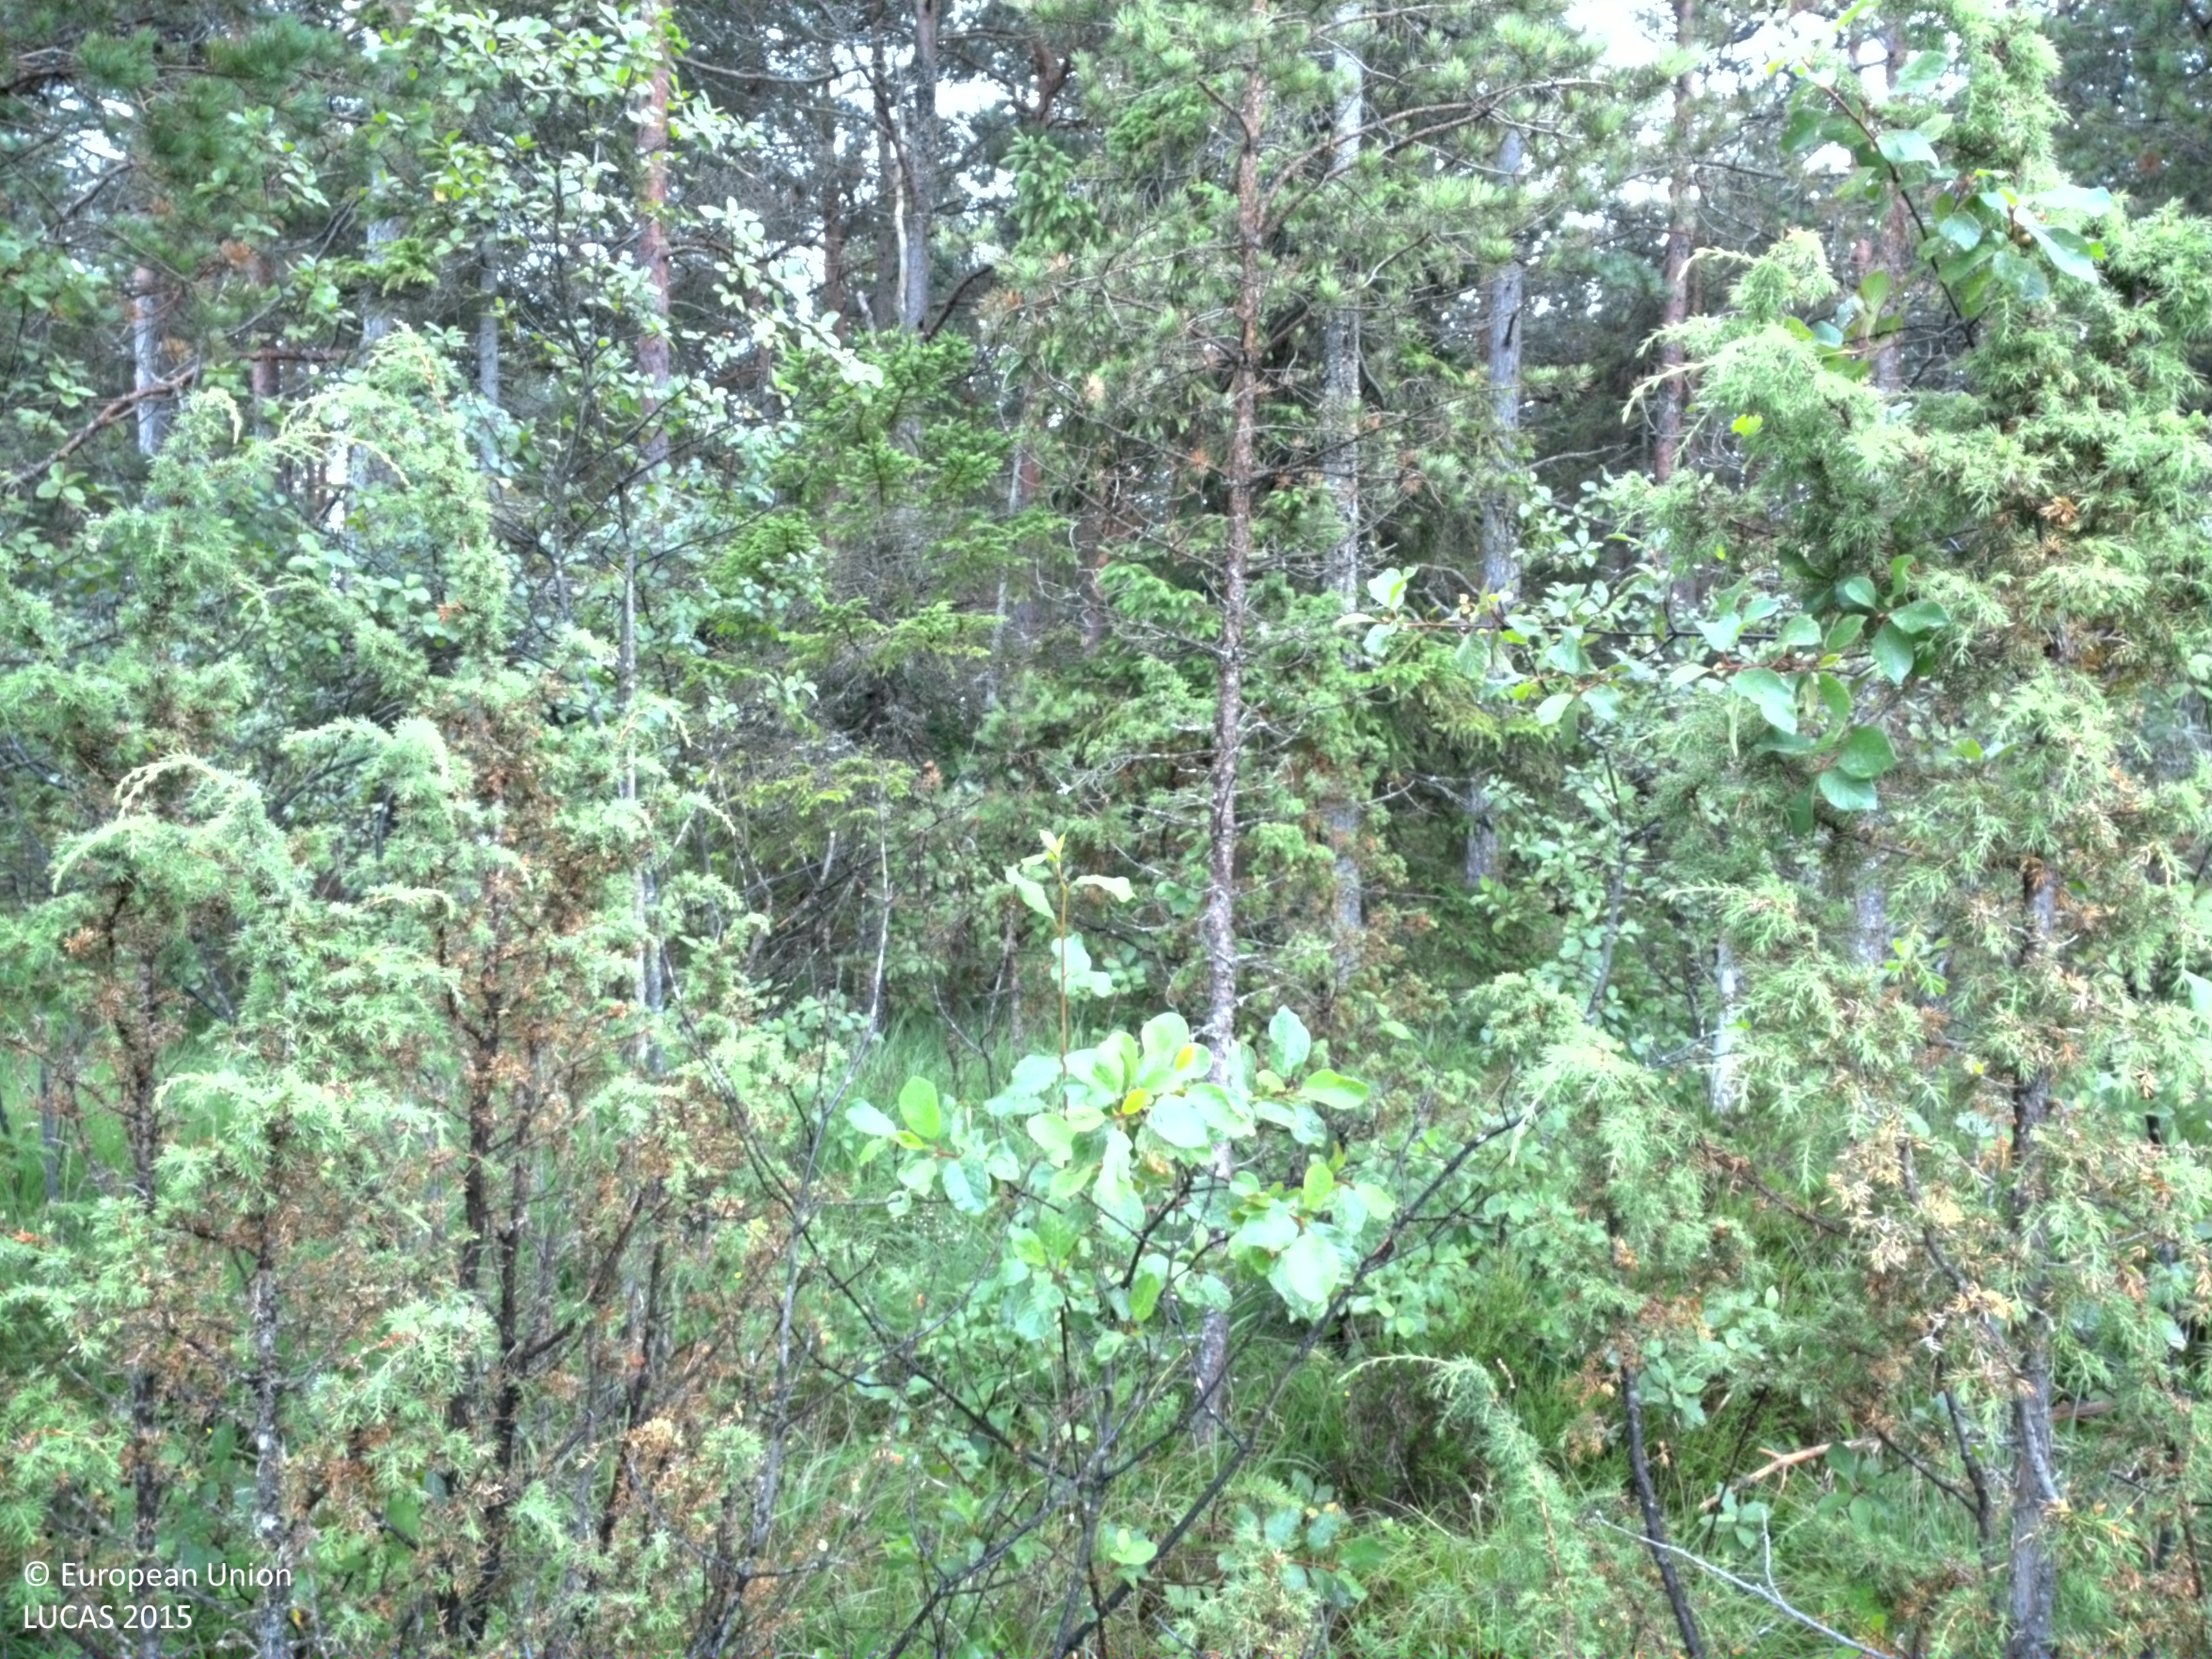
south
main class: Woodland
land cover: Pine dominated coniferous woodland
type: hemiboreal forest and nemoral coniferous forest and mixed broadleaved-coniferous forest
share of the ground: > 75 %
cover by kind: coniferous forest trees 60 %, herbaceous plants 20 %, shrubs 15 %, broadleaved forest trees 5 %
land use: Forestry
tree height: < 5 m
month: July
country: SE
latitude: 57.4867
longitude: 18.6673
